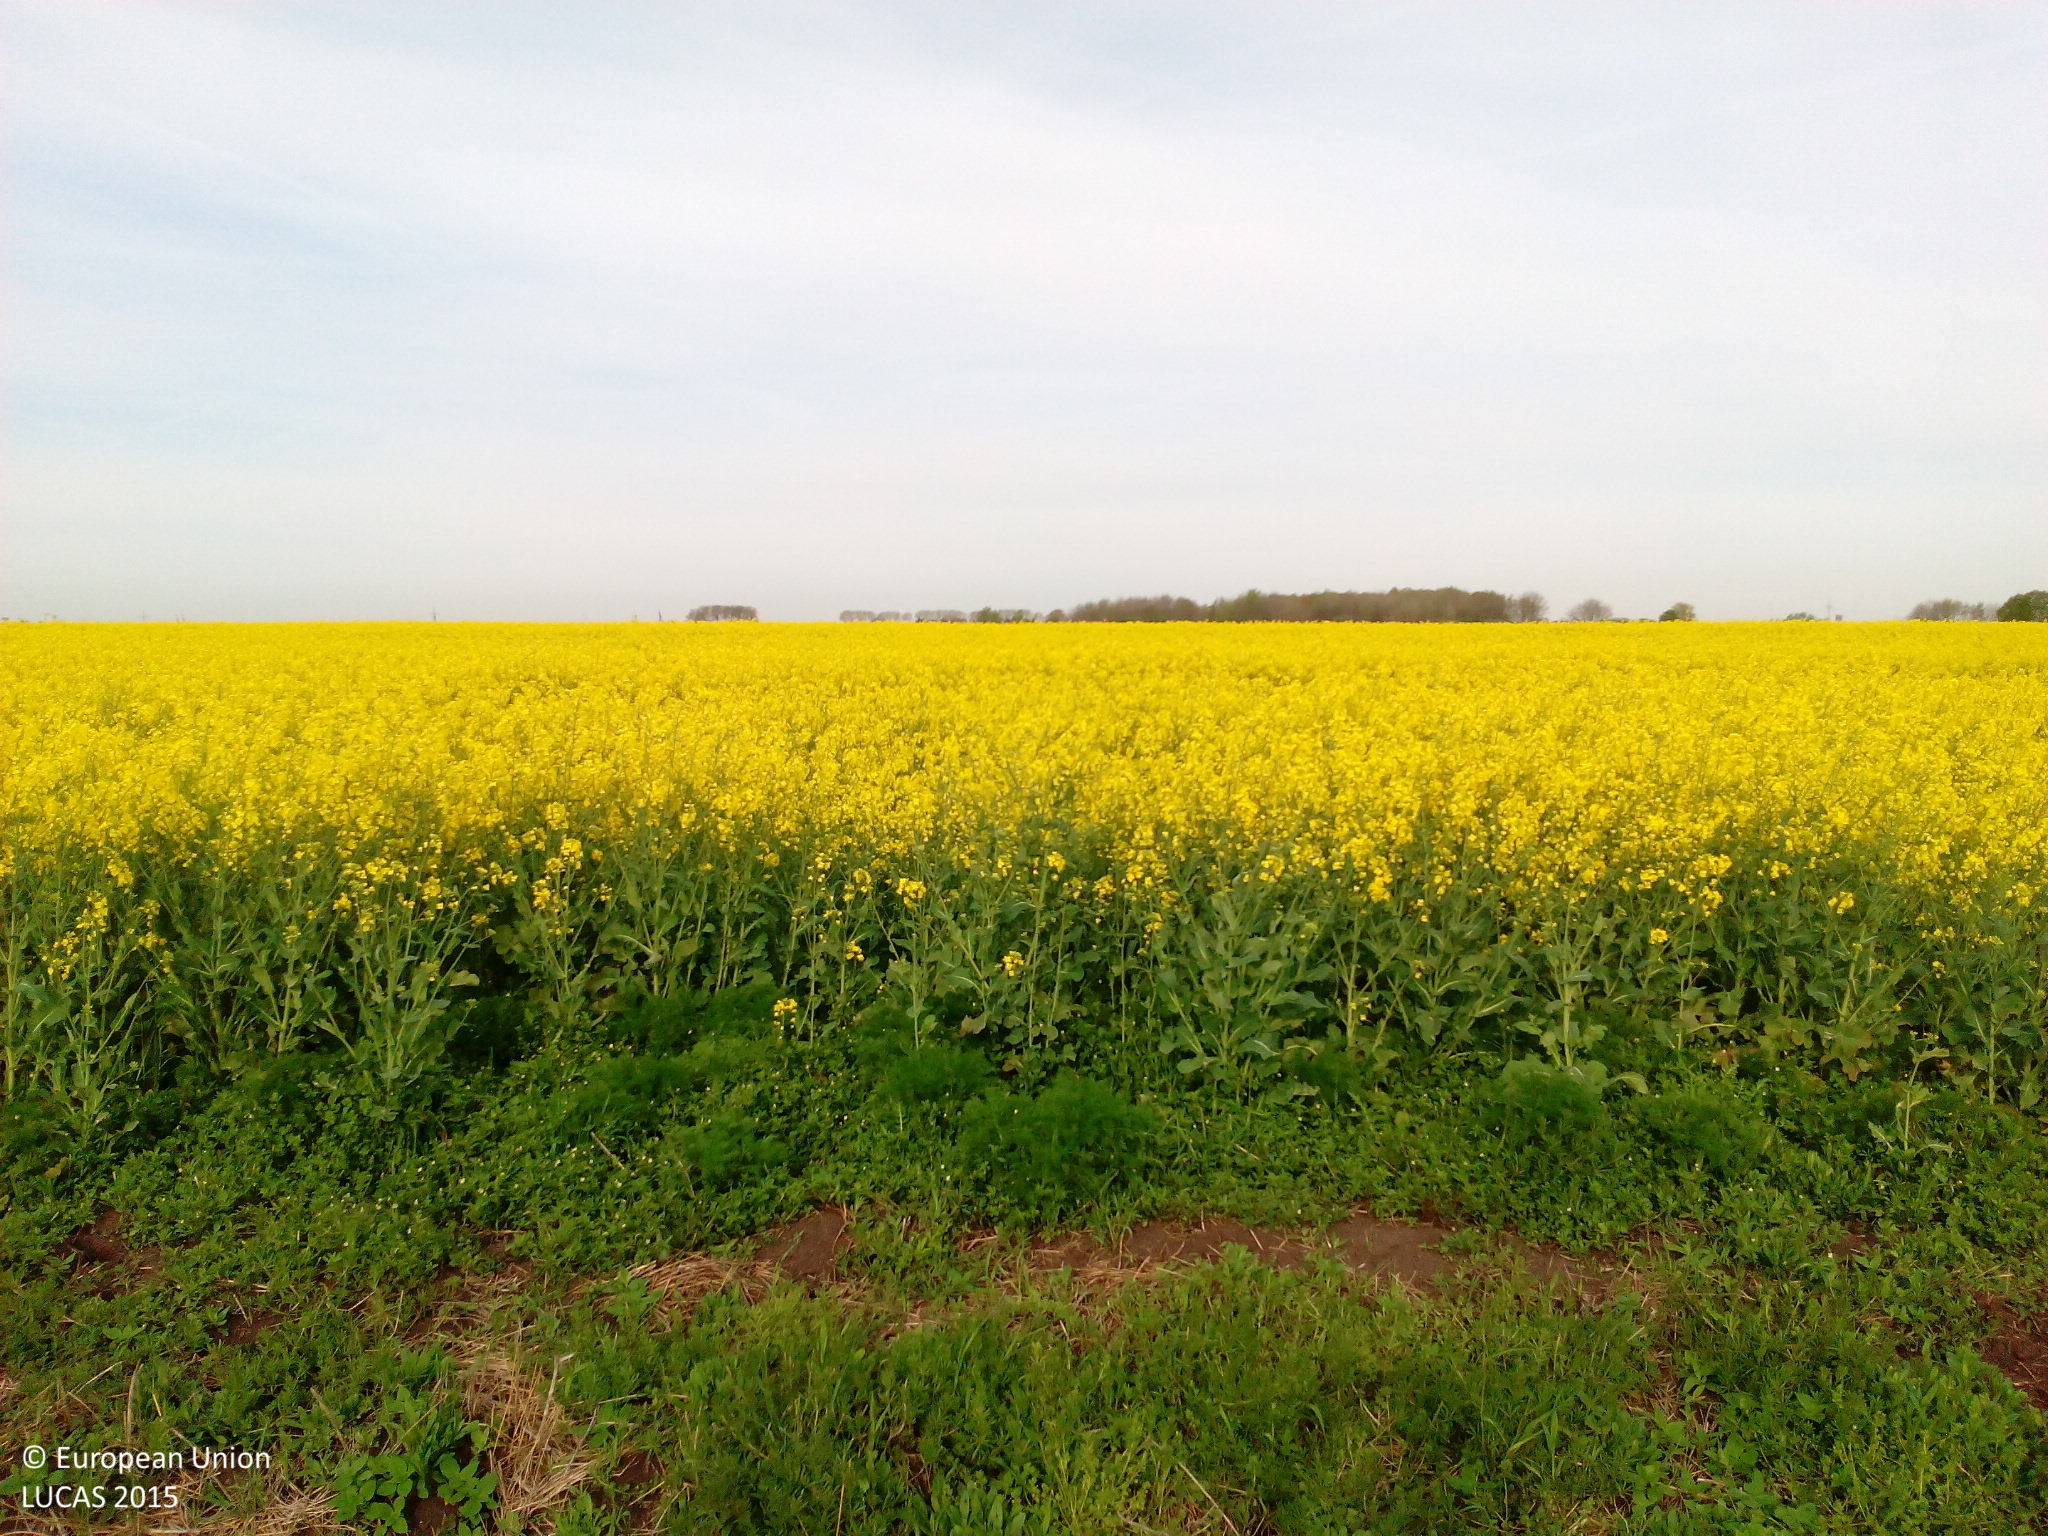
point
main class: Cropland
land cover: Rape and turnip rape
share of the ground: > 75 %
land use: Agriculture (excluding fallow land and kitchen gardens)
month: May
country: DE
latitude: 53.3755
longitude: 8.5726
